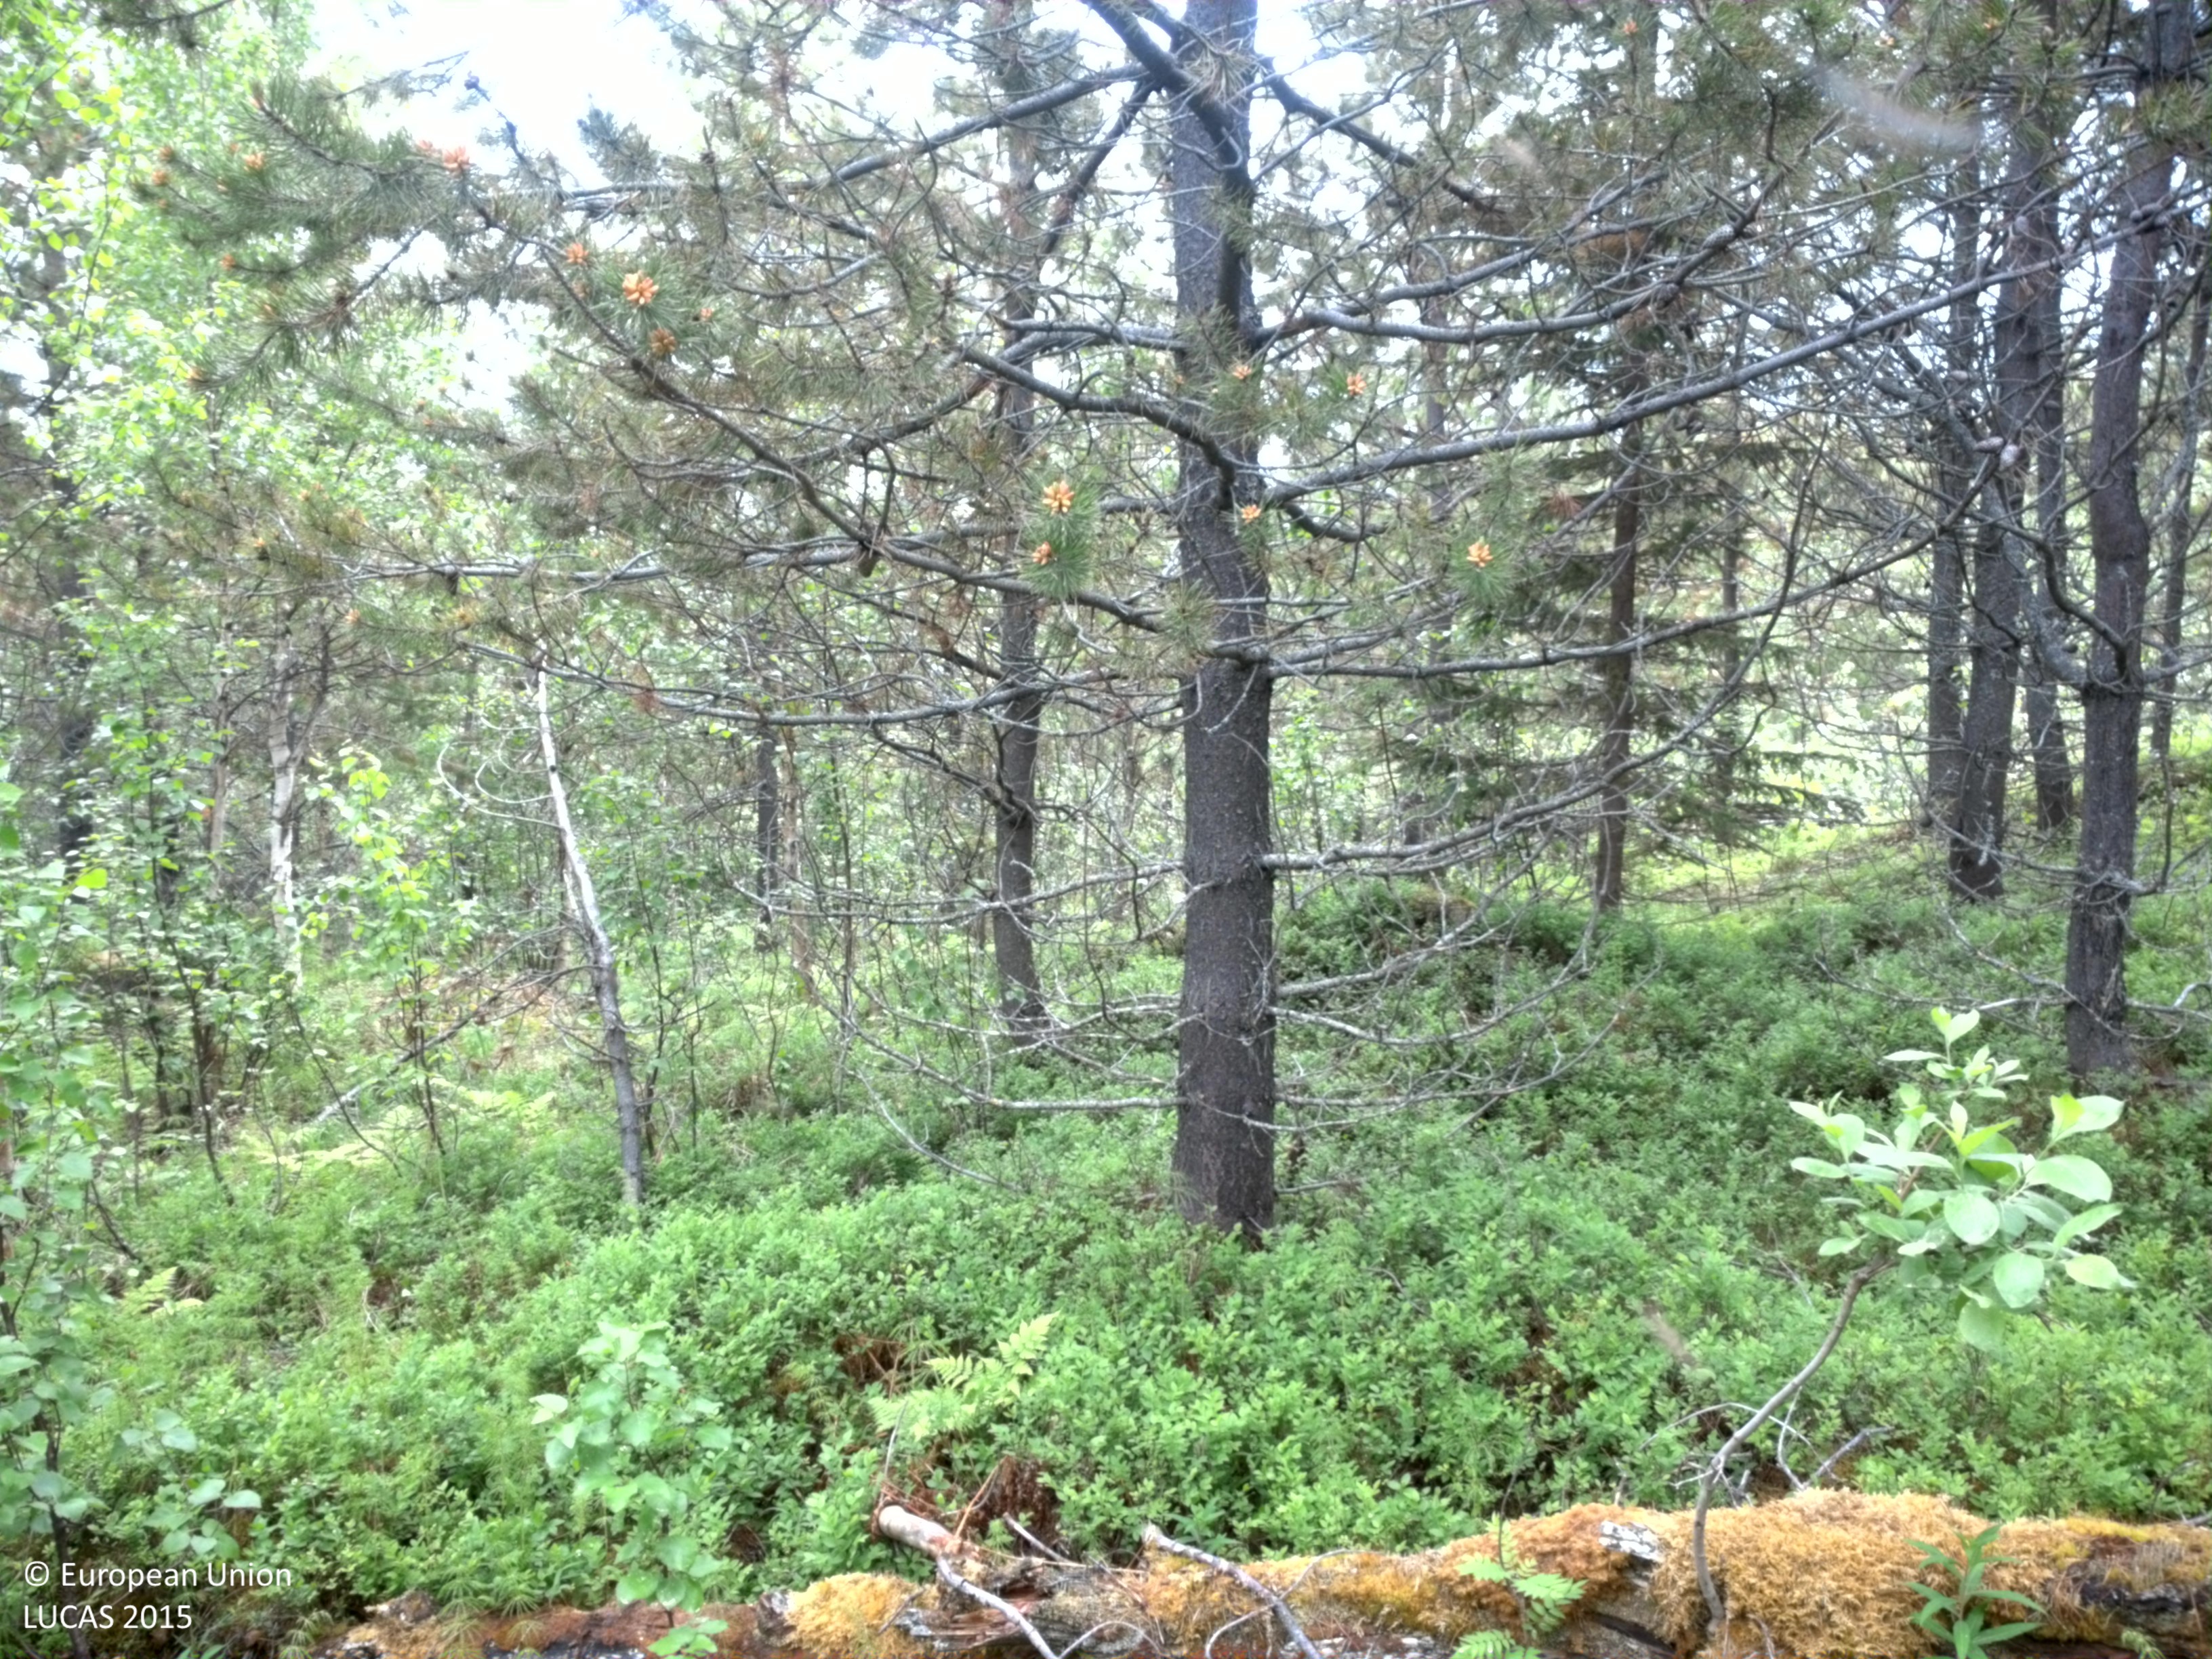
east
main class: Woodland
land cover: Pine dominated coniferous woodland
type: exotic forest
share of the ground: 50 - 75 %
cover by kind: coniferous forest trees 65 %, broadleaved forest trees 15 %, shrubs 15 %, herbaceous plants 5 %
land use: Forestry
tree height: > 5 m
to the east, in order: Pine dominated coniferous woodland; Pine dominated mixed woodland; Rivers and streams; Broadleaved woodland; Pine dominated coniferous woodland; Pine dominated mixed woodland; Rivers and streams; Pine dominated mixed woodland; Pine dominated coniferous woodland; Pine dominated mixed woodland; Grassland with sparse tree/shrub cover; Spruce dominated mixed woodland
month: July
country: SE
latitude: 64.4700
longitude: 17.9741
